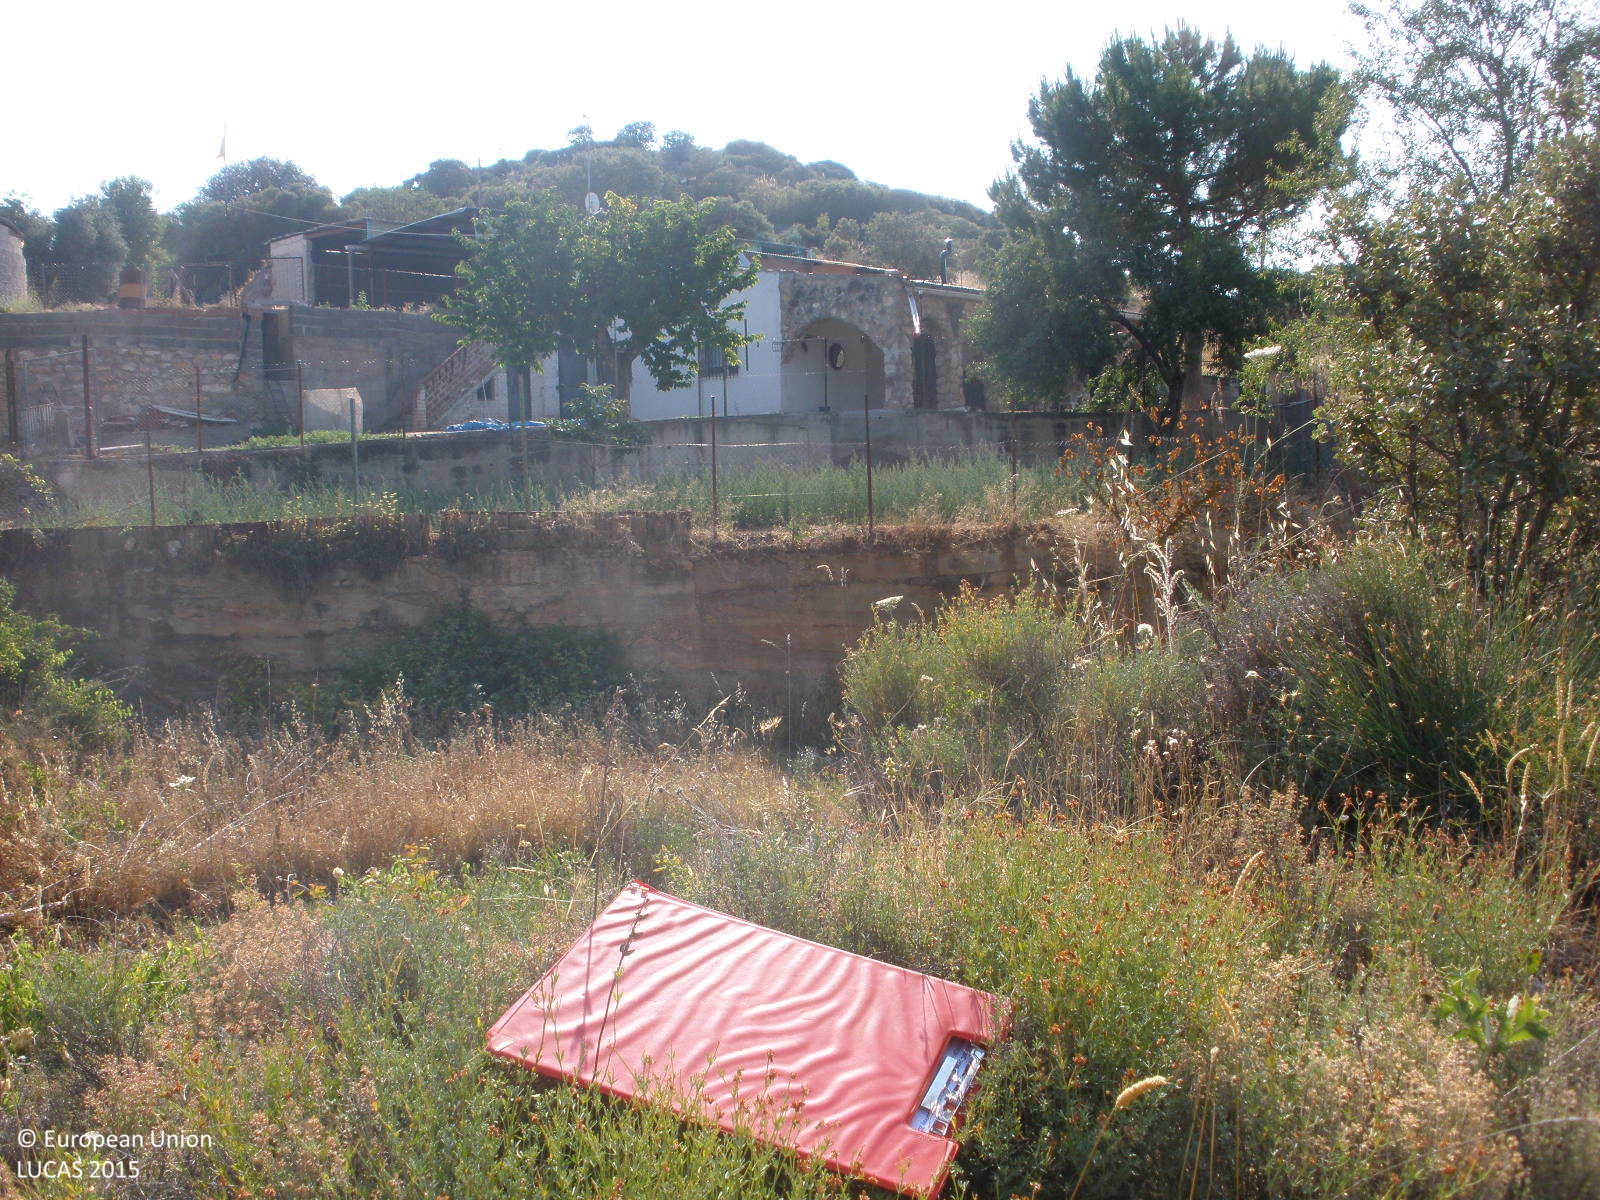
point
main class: Shrubland
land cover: Shrubland with sparse tree cover
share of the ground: 50 - 75 %
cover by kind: shrubs 60 %, herbaceous plants 25 %, consolidated bare surface 10 %, broadleaved forest trees 5 %
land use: Semi-natural and natural areas not in use
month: June
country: ES
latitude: 40.2927
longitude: -3.2883
